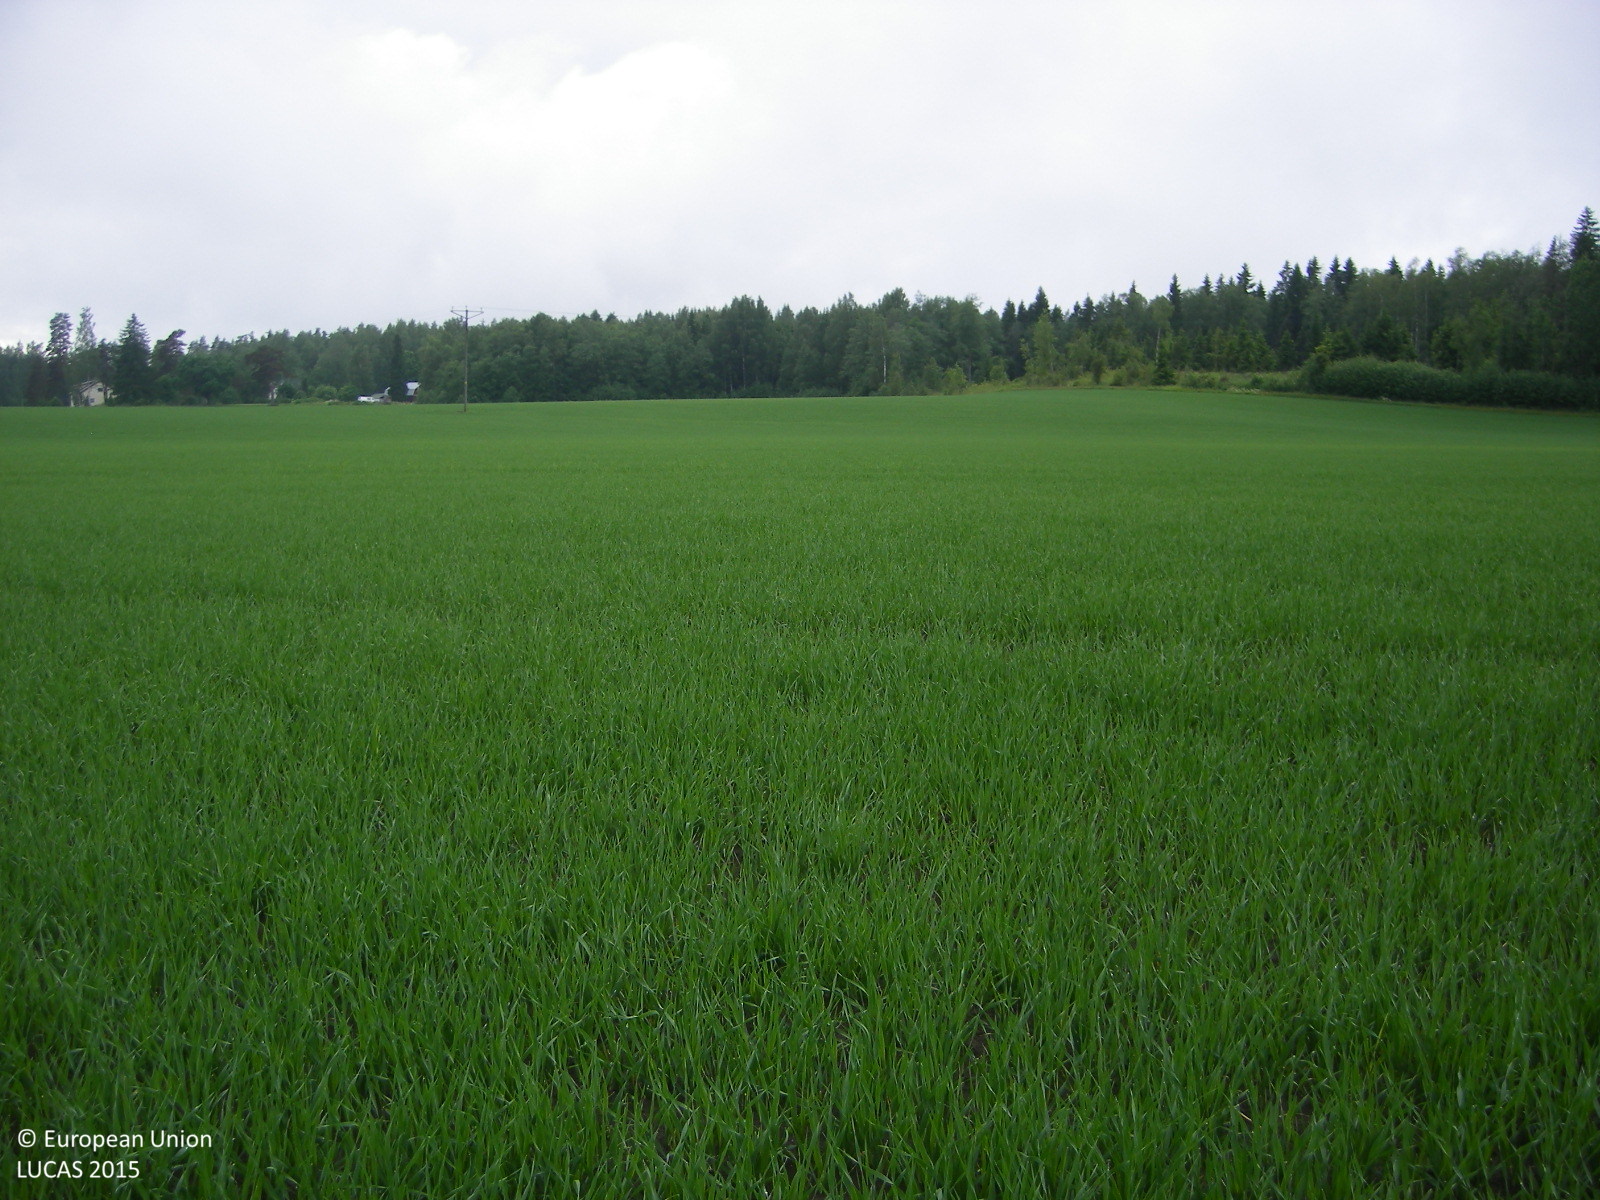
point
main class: Cropland
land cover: Common wheat
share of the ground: > 75 %
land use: Agriculture (excluding fallow land and kitchen gardens)
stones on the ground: < 10 %
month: June
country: FI
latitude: 60.1463
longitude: 23.9103
